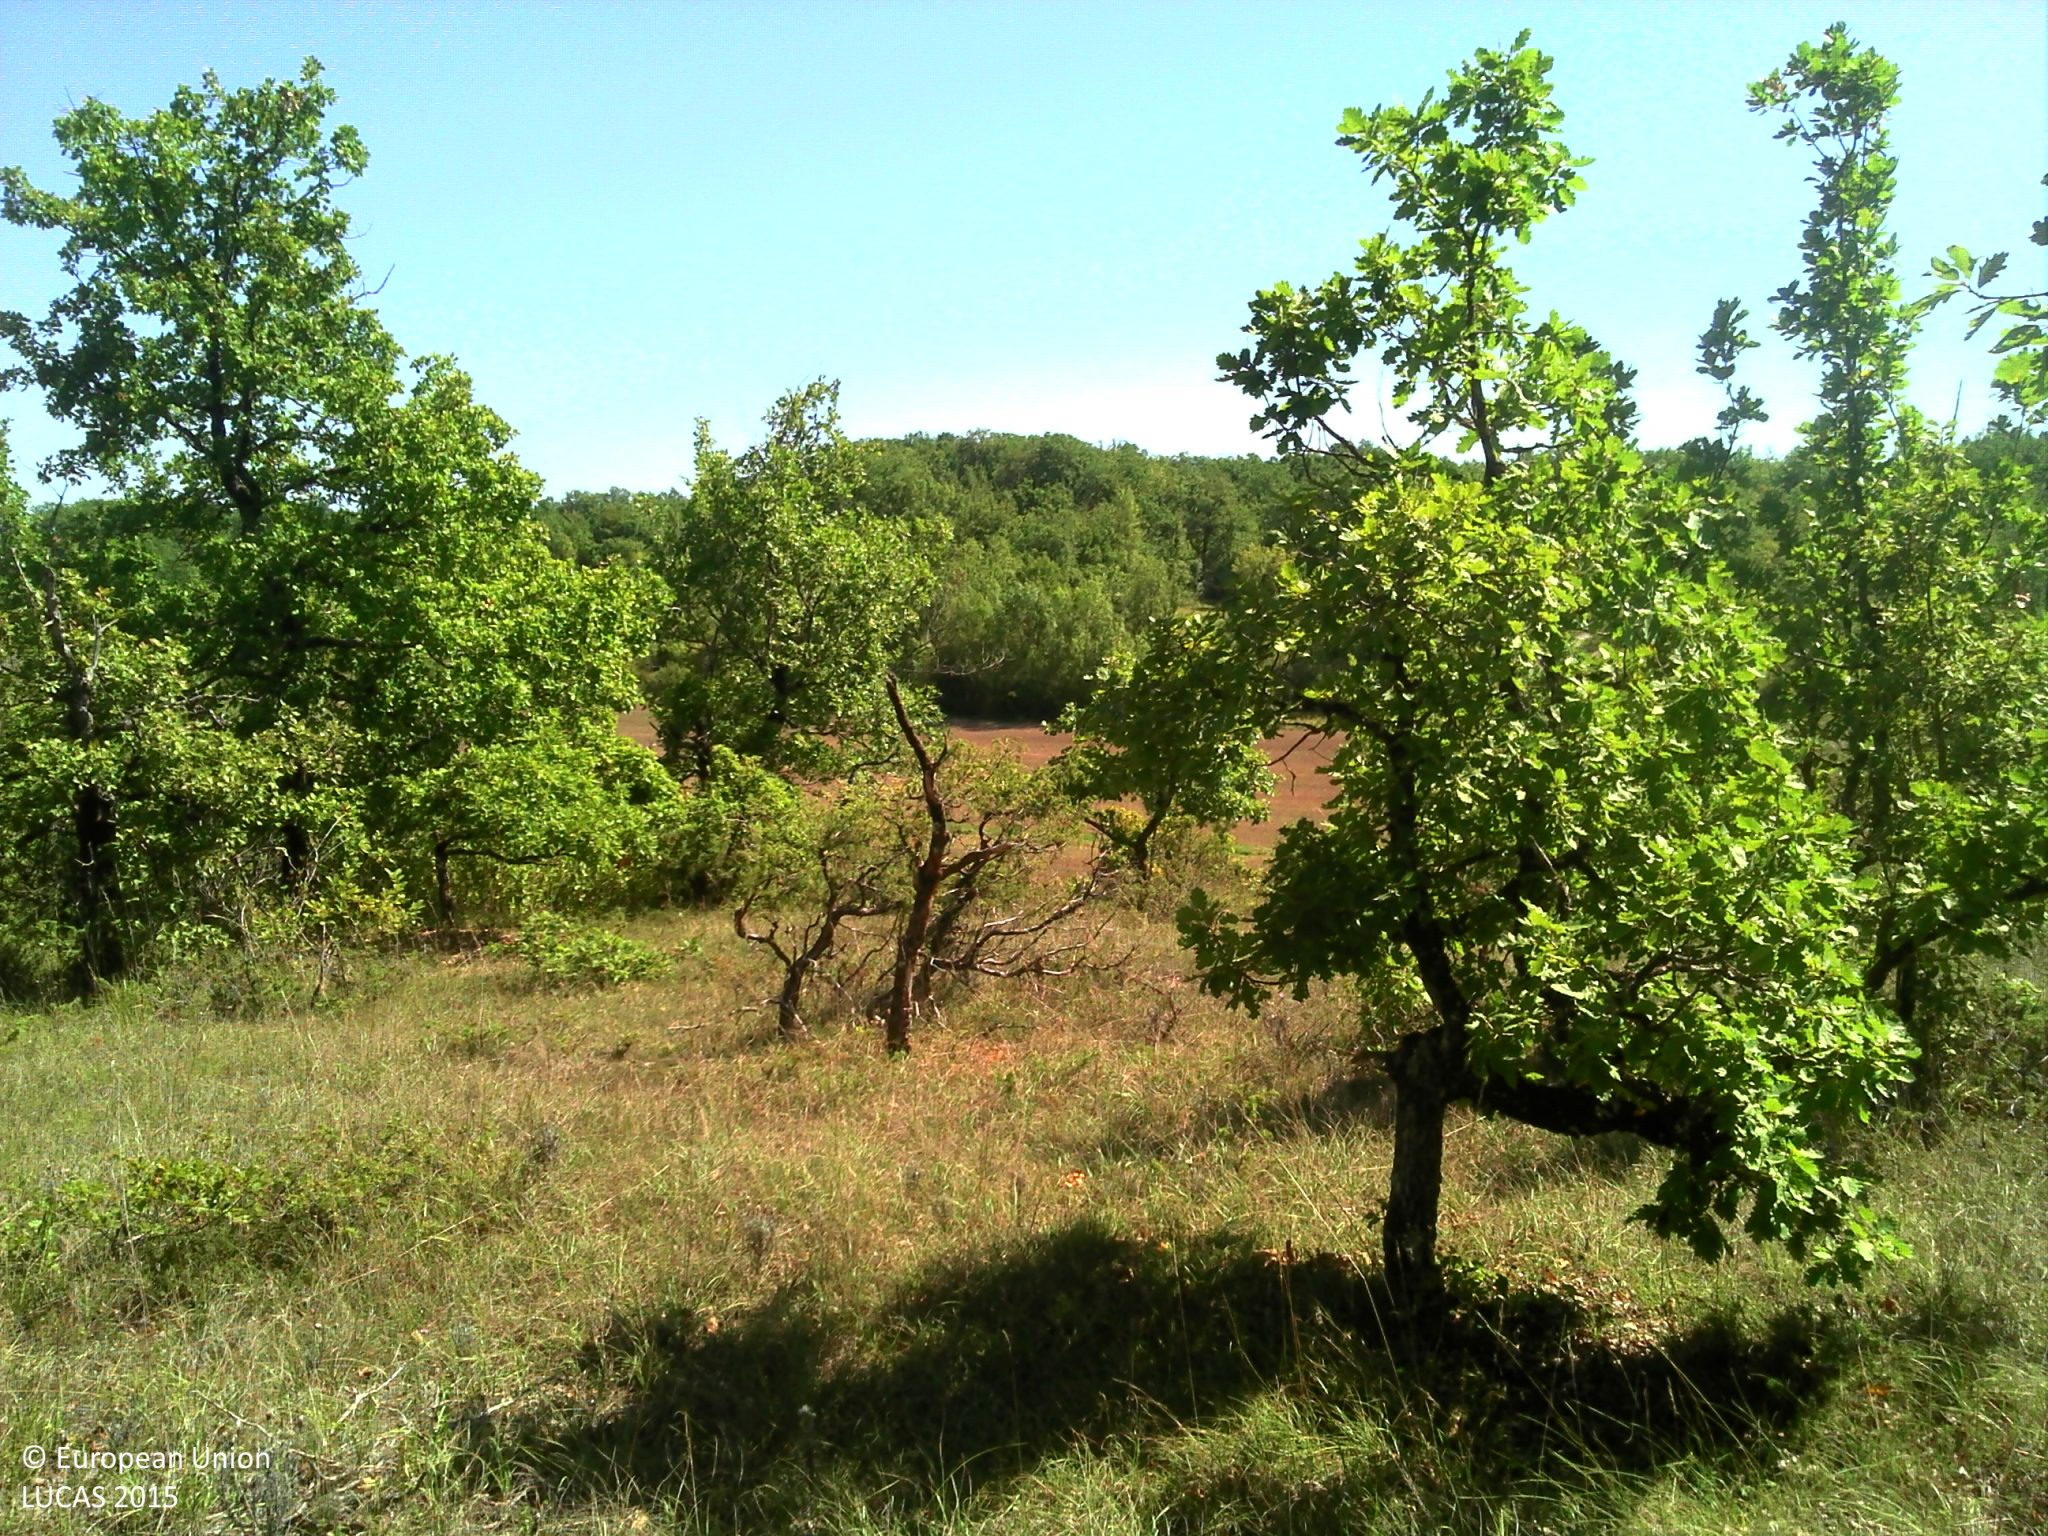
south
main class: Woodland
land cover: Broadleaved woodland
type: thermophilous deciduous forest
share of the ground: > 75 %
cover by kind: broadleaved forest trees 50 %, herbaceous plants 35 %, shrubs 10 %, lichens and mosses 5 %
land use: Forestry
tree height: > 5 m
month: August
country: FR
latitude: 44.3263
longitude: 1.4845
